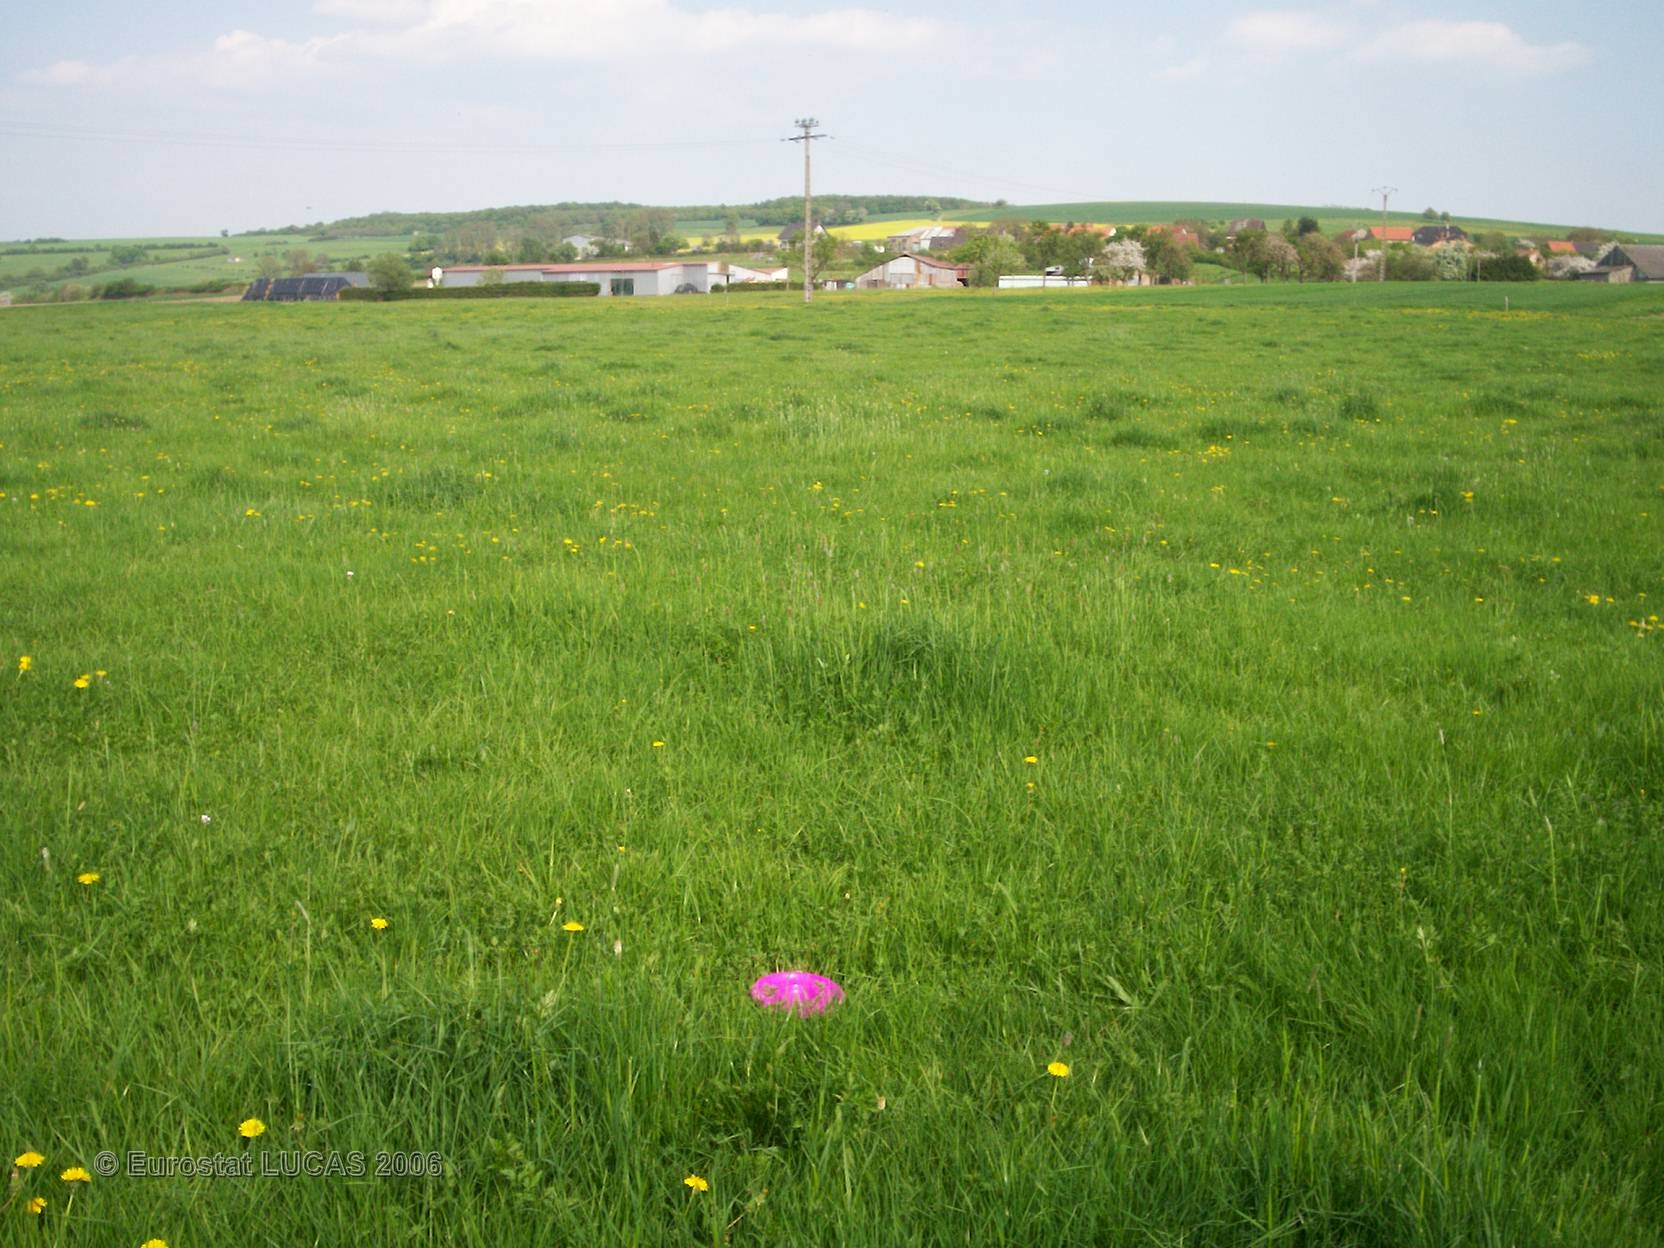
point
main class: Grassland
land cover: Grassland without tree/shrub cover
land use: Agriculture (excluding fallow land and kitchen gardens)
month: May
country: FR
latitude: 48.9047
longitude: 7.0673
